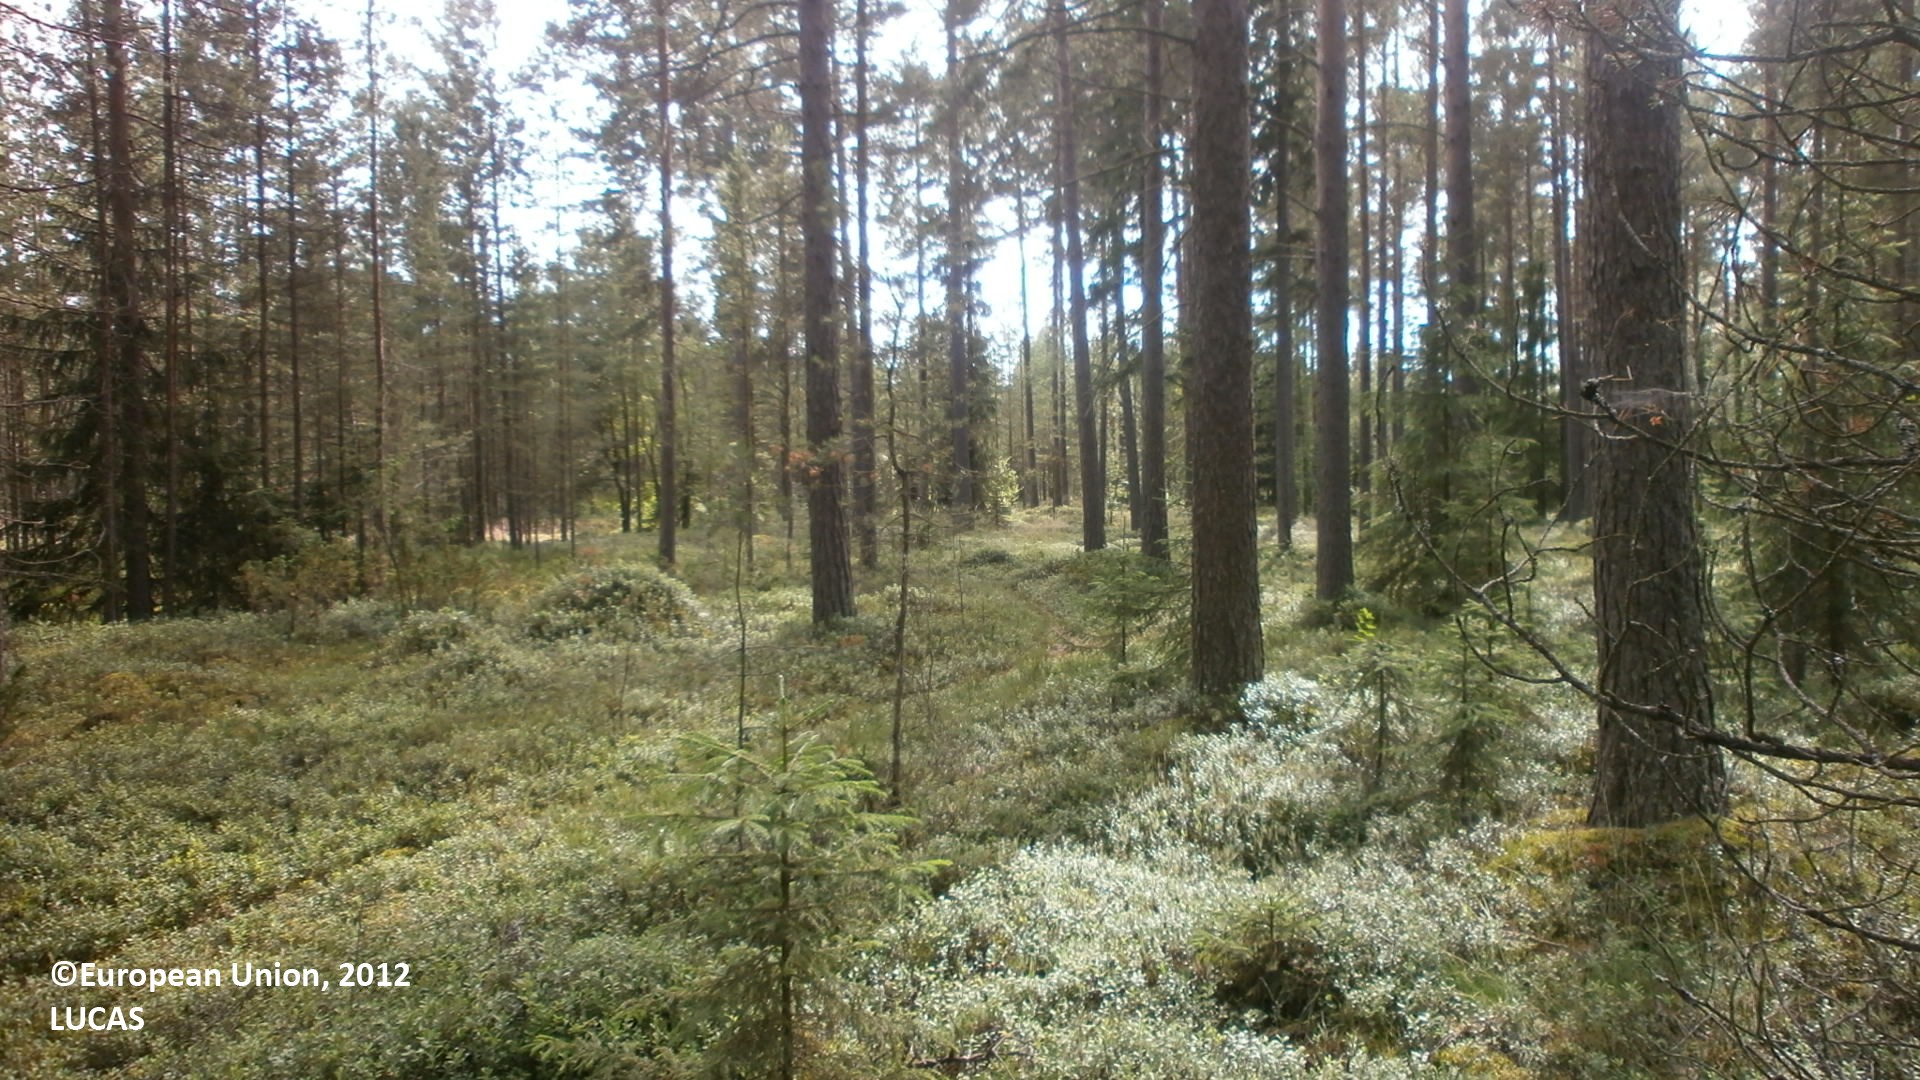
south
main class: Woodland
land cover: Pine dominated coniferous woodland
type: boreal forest
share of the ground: 50 - 75 %
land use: Forestry
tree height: > 5 m
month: July
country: FI
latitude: 64.2461
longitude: 23.8601
